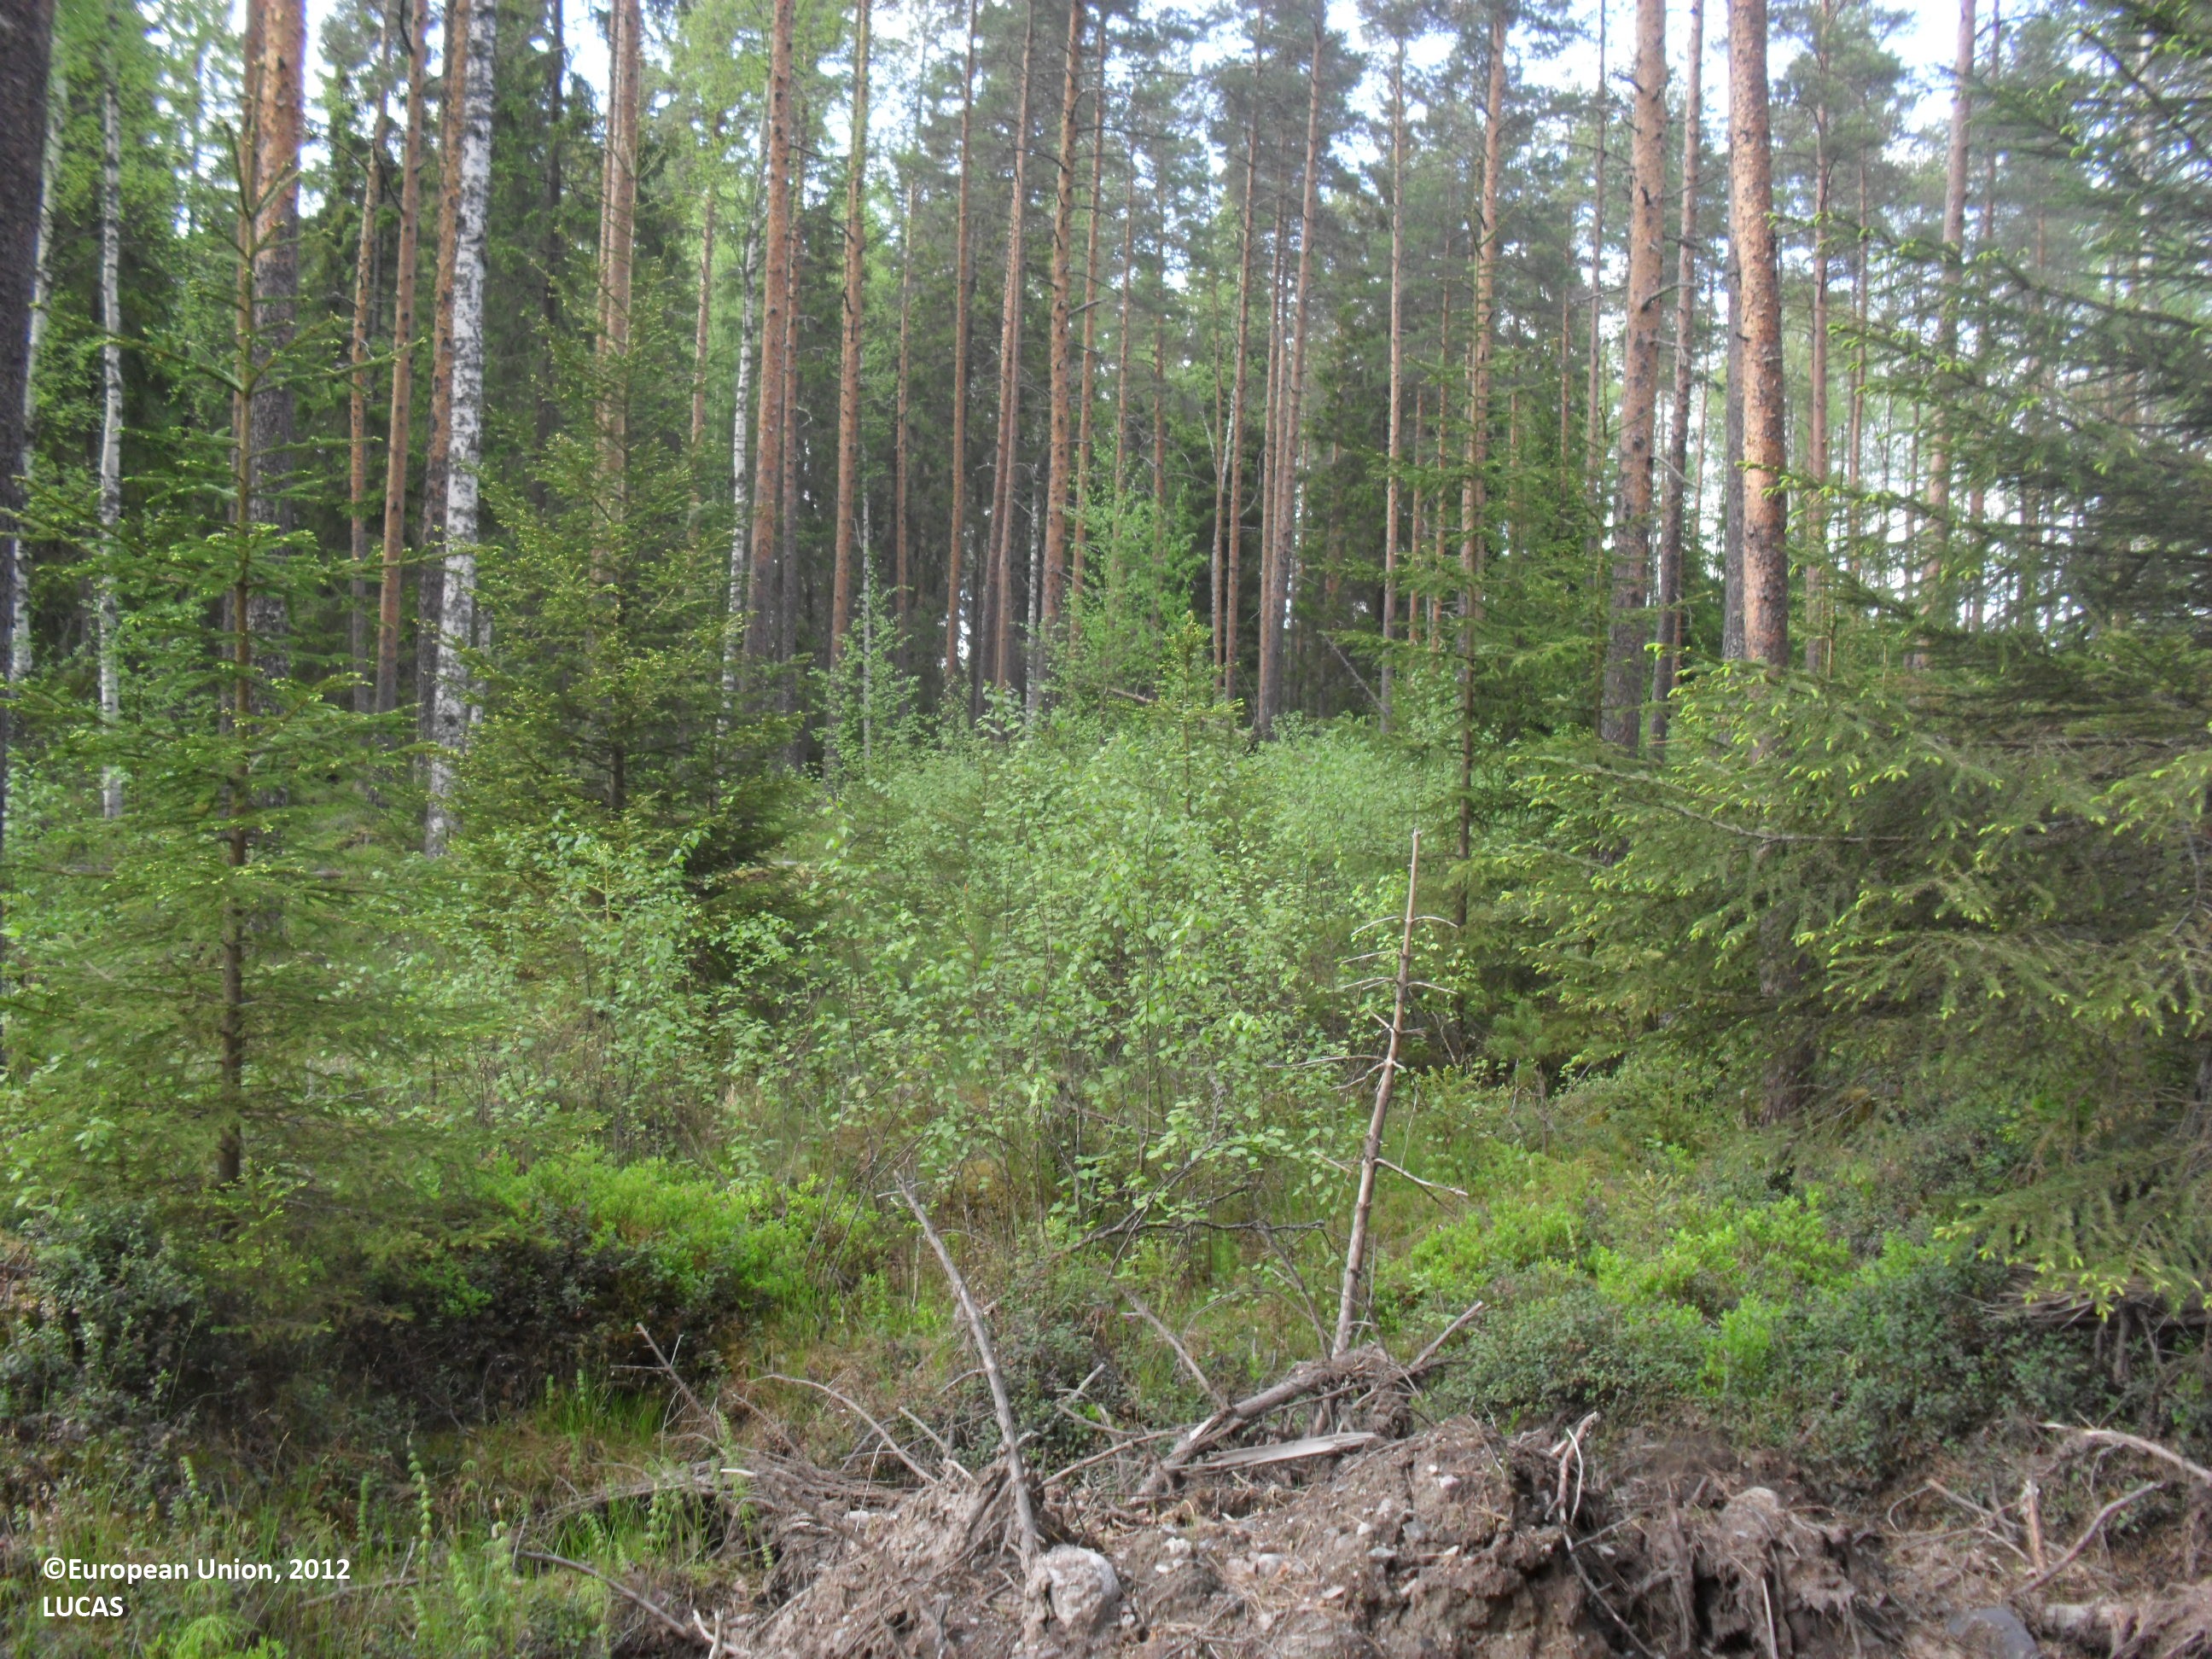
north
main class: Woodland
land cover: Other coniferous woodland
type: boreal forest
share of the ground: 25 - 50 %
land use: Forestry
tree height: > 5 m
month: June
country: FI
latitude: 62.8389
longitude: 23.3591
